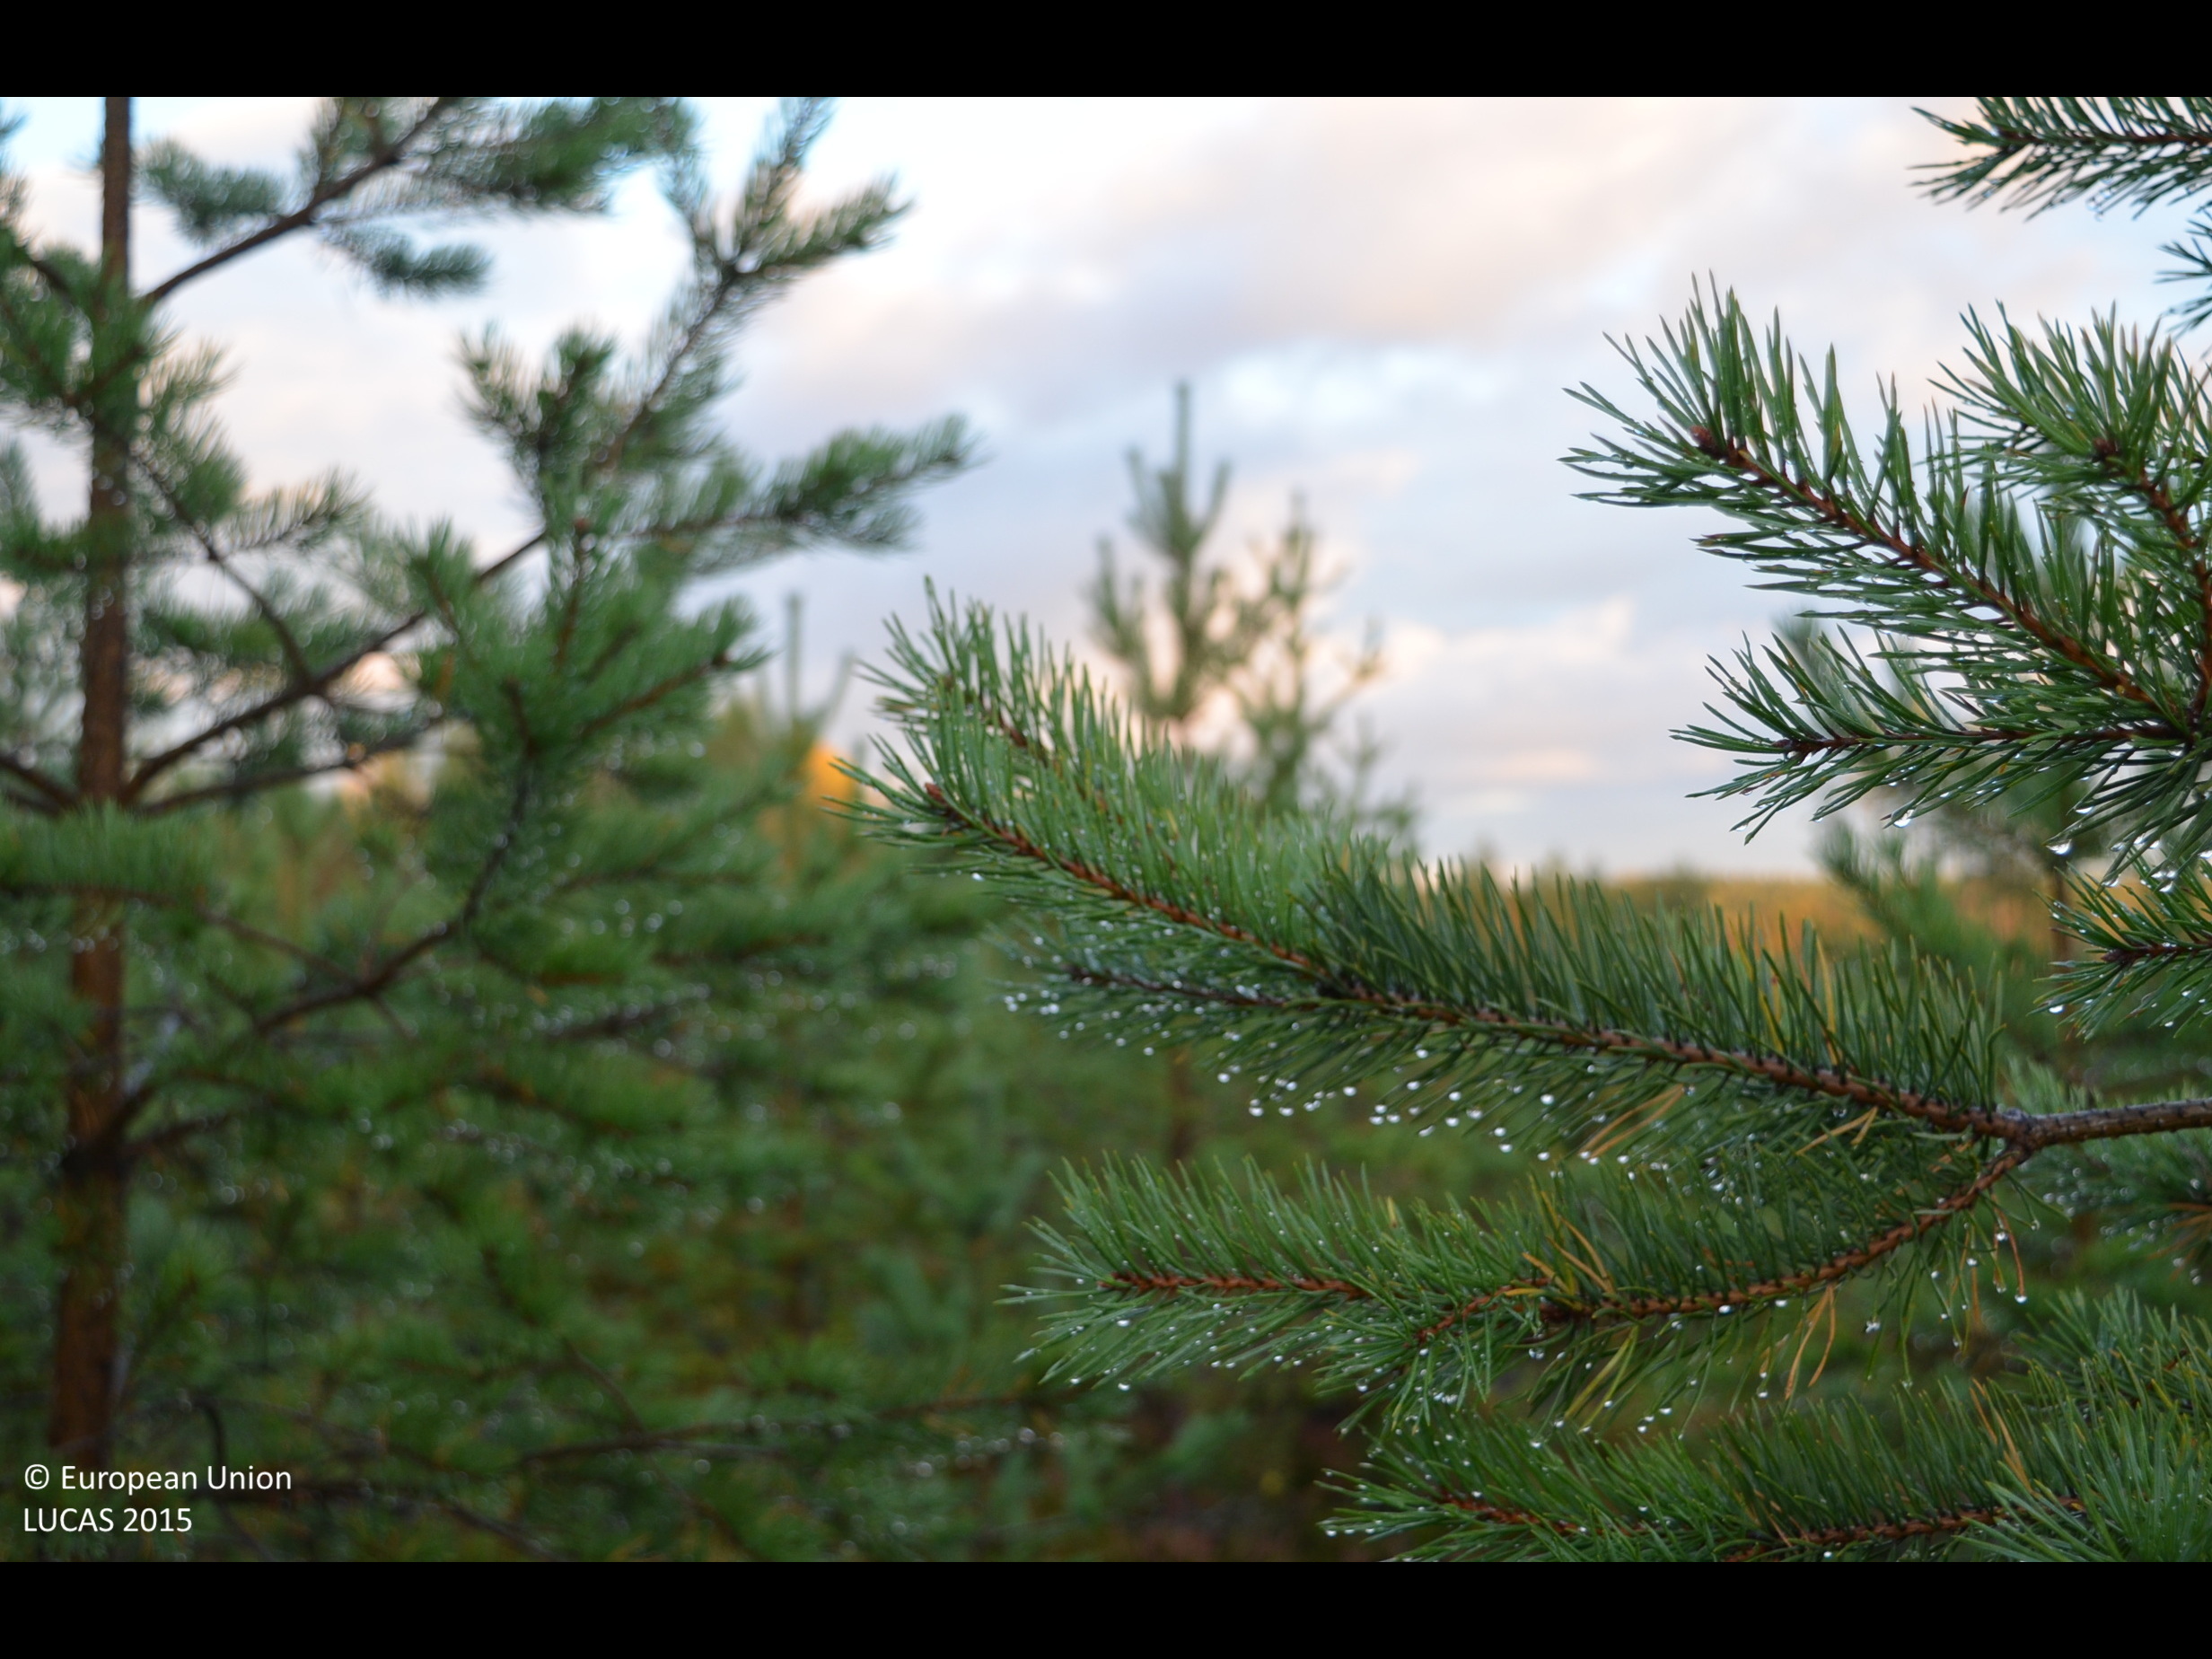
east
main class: Woodland
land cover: Pine dominated coniferous woodland
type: boreal forest
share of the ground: > 75 %
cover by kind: coniferous forest trees 75 %, shrubs 25 %
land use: Forestry
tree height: < 5 m
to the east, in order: Pine dominated coniferous woodland; Other mixed woodland; Ditches and canals; Artificial constructions in urban areas; Ditches and canals; Grass margins; Paved roads, cycling and walking lanes; Grass margins; Ditches and canals; Grassland without tree/shrub cover
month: September
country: FI
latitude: 62.7480
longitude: 23.7564
